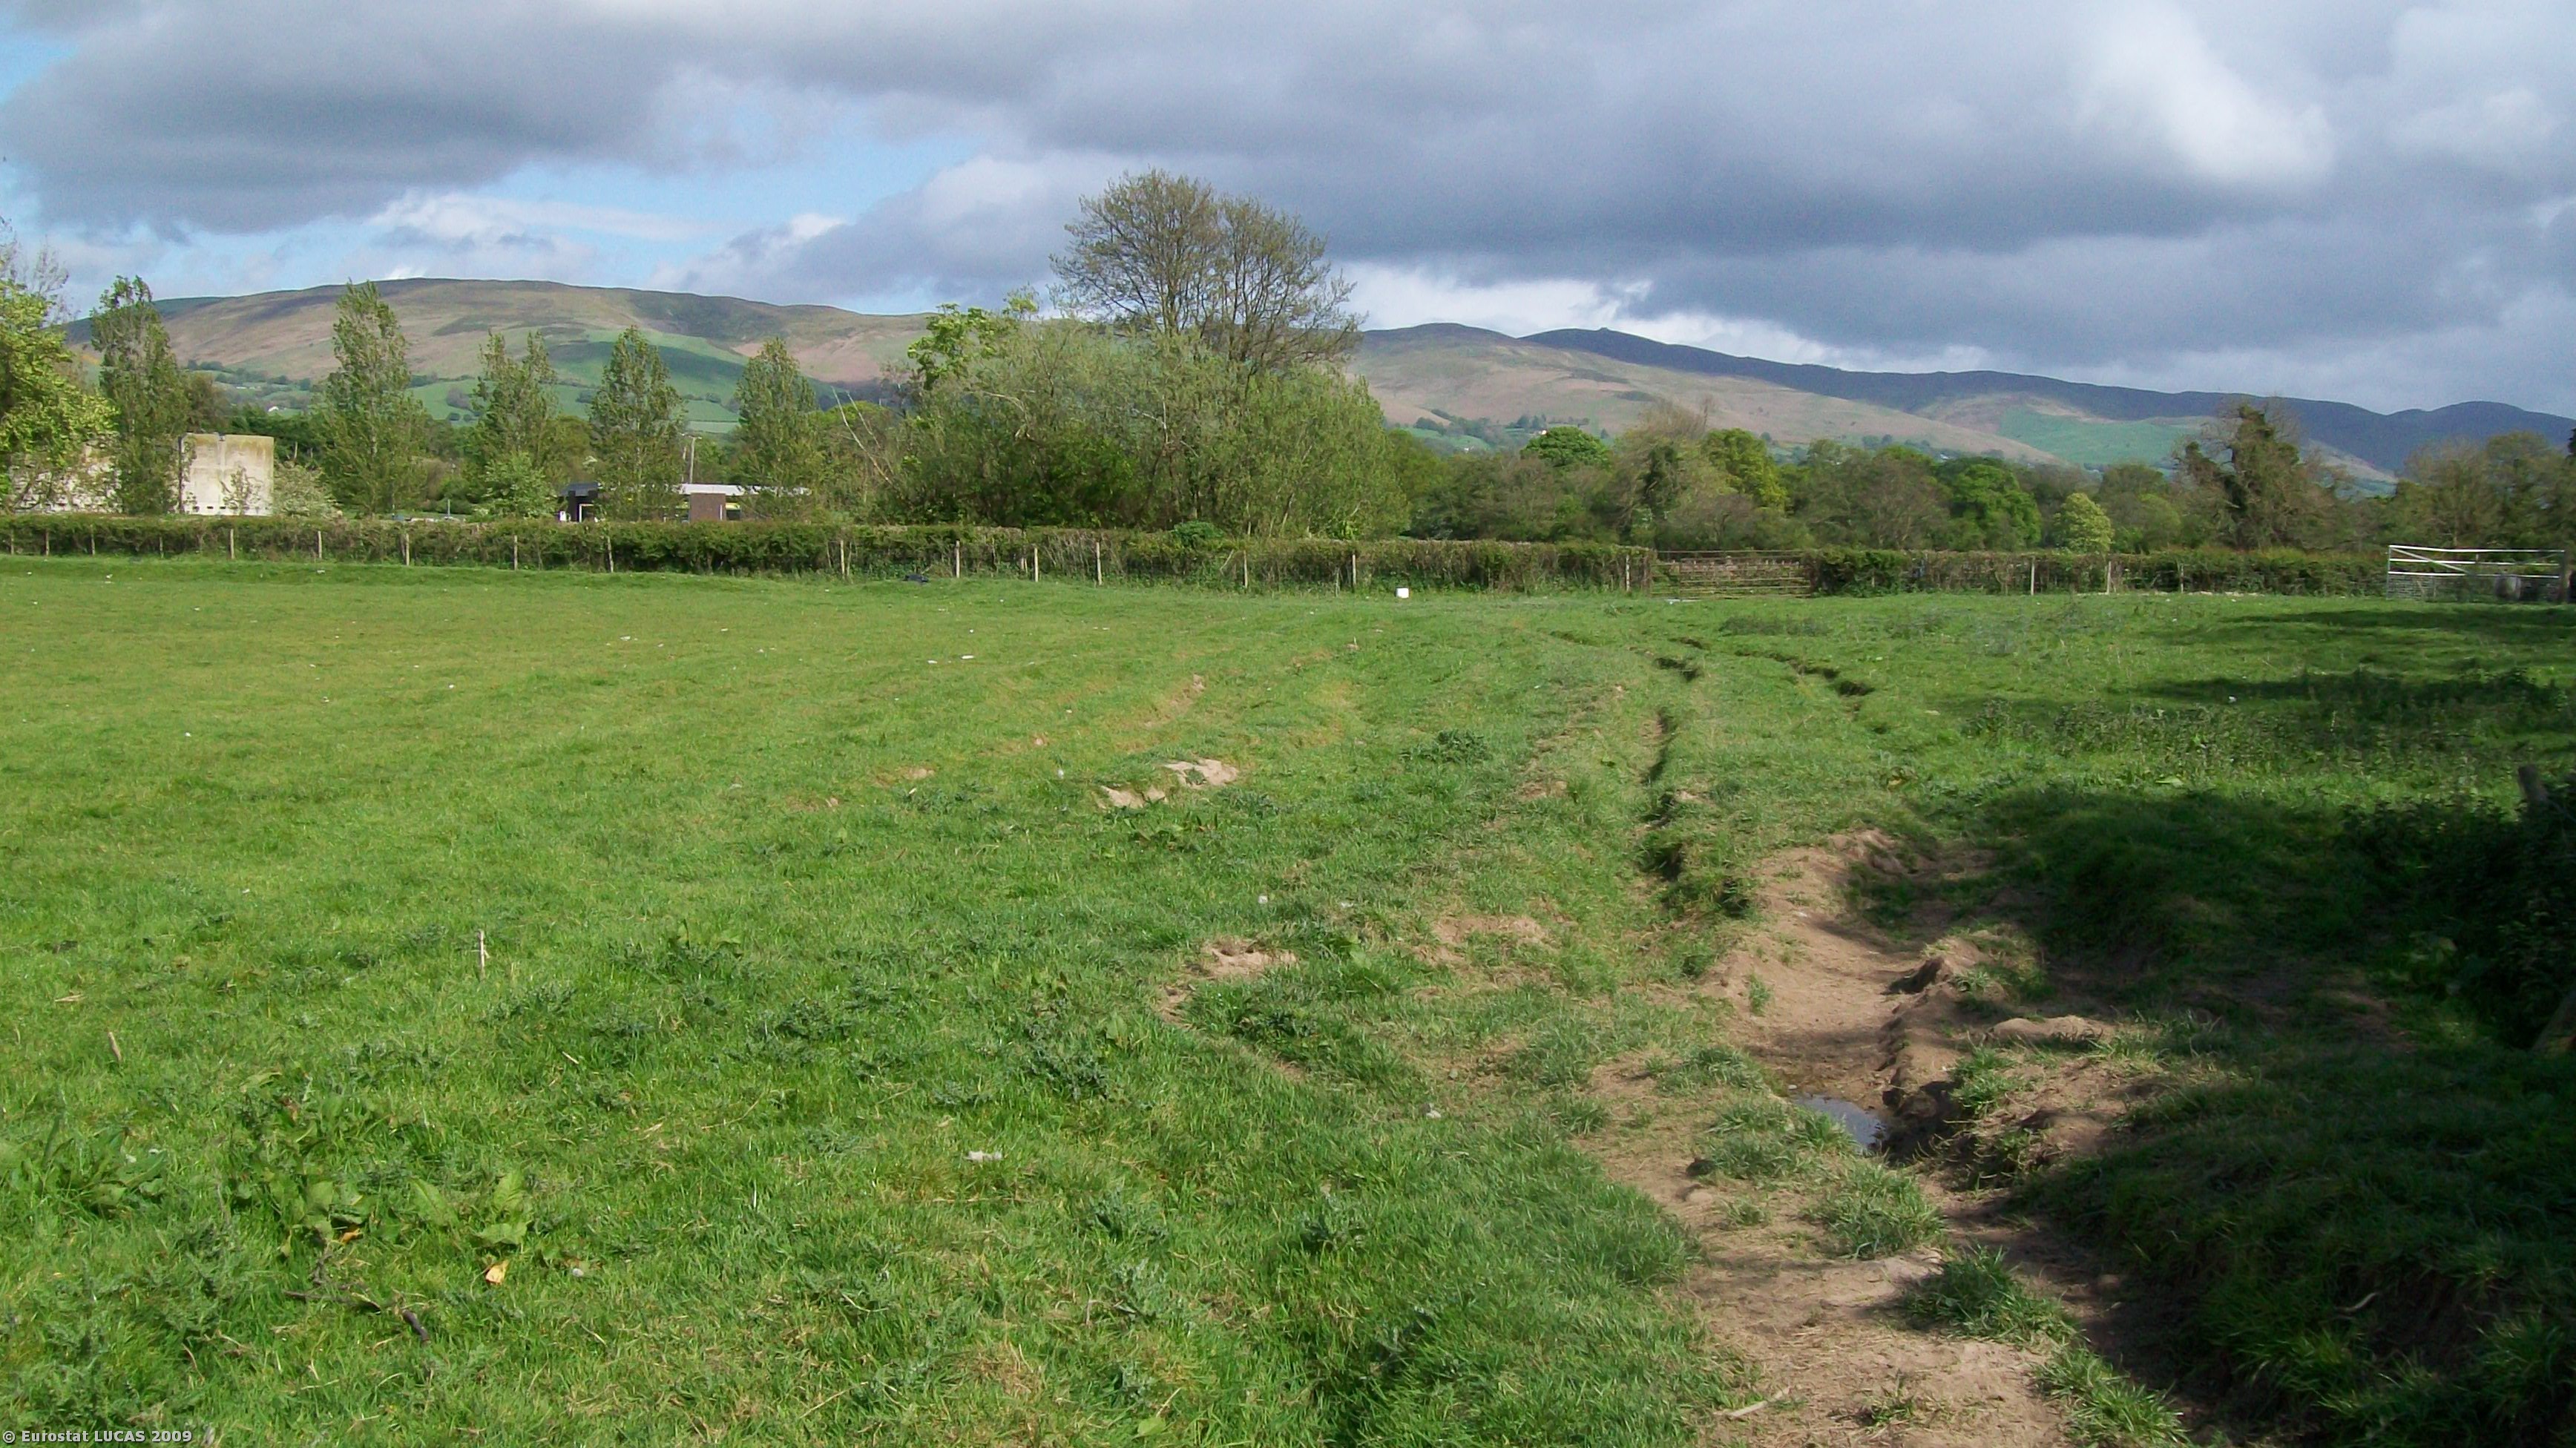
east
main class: Grassland
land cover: Grassland without tree/shrub cover
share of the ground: > 75 %
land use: Agriculture (excluding fallow land and kitchen gardens)
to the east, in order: Grassland without tree/shrub cover; Fences; Managed hedges; Paved roads, cycling and walking lanes; Fences; Managed hedges; Ditches and canals; Grassland without tree/shrub cover; Fences; Lines of trees; Grassland without tree/shrub cover; Artificial constructions; Single bushes/trees
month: May
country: GB
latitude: 53.1690
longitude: -3.3498
